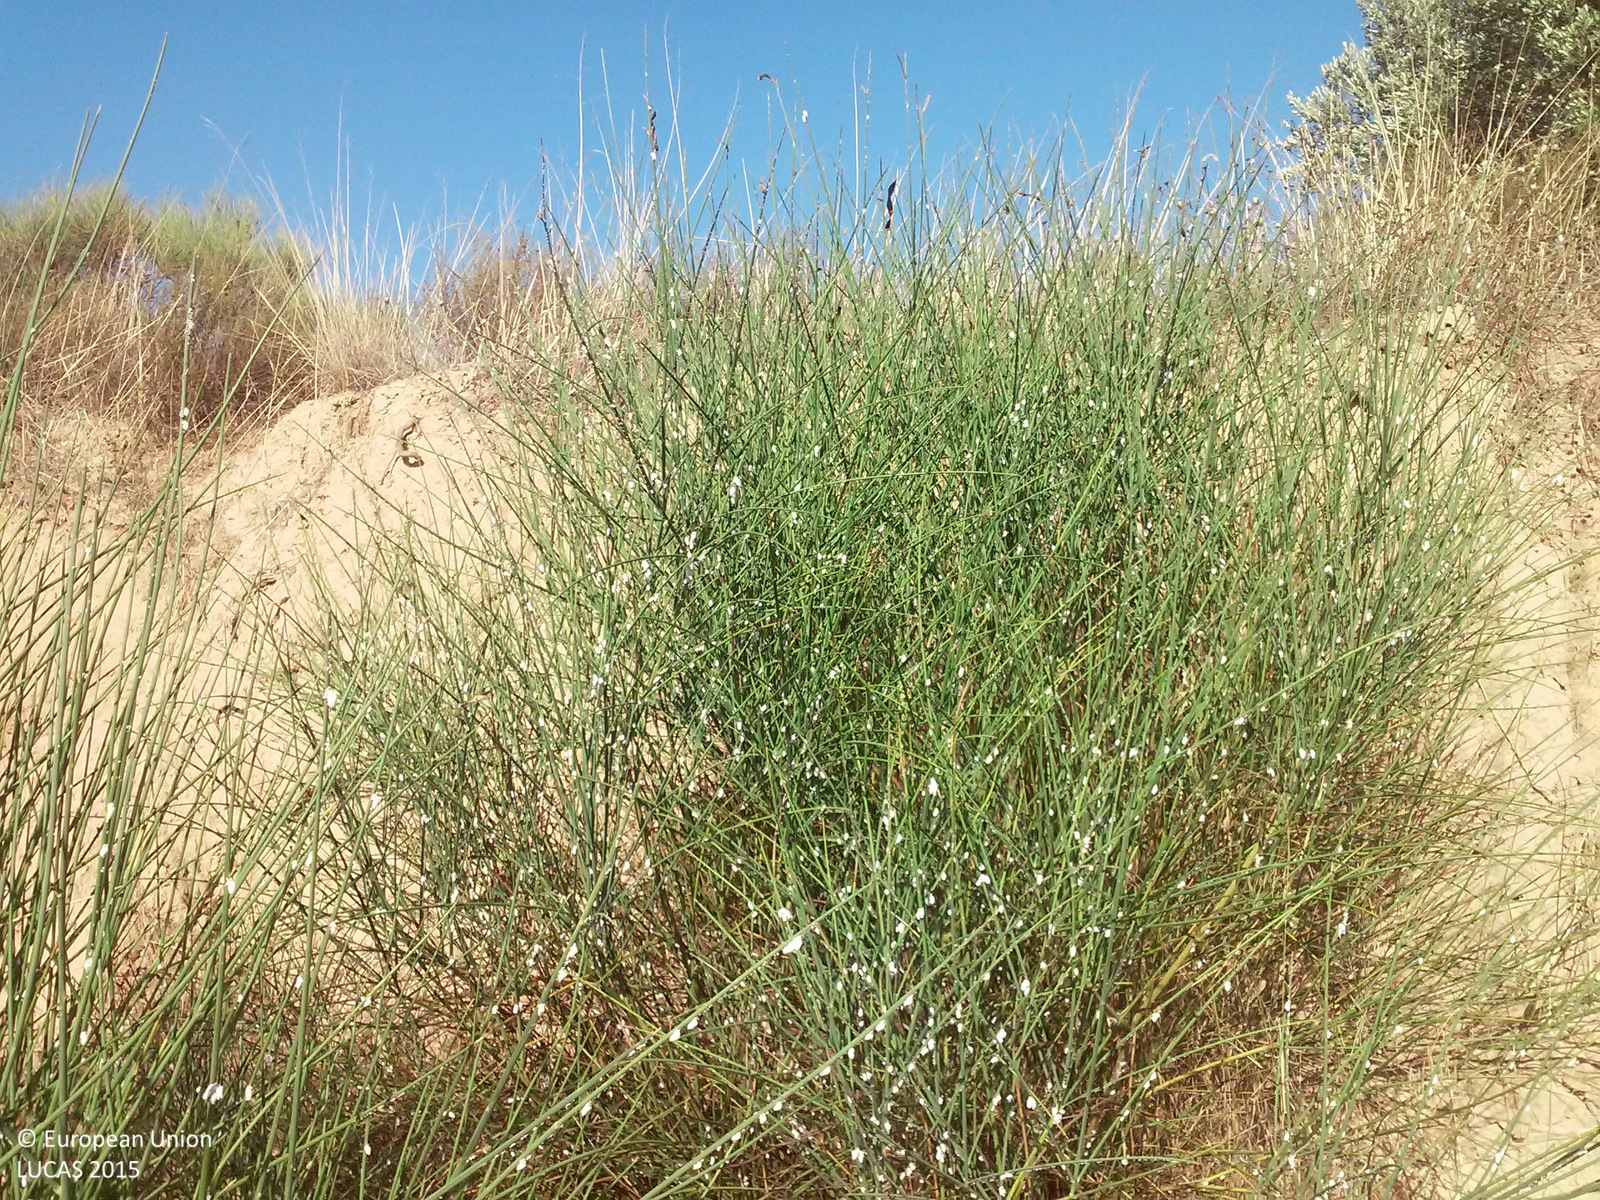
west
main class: Grassland
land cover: Grassland without tree/shrub cover
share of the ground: 25 - 50 %
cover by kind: herbaceous plants 95 %, shrubs 5 %
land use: Semi-natural and natural areas not in use
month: August
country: ES
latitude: 41.2277
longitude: 0.5302
